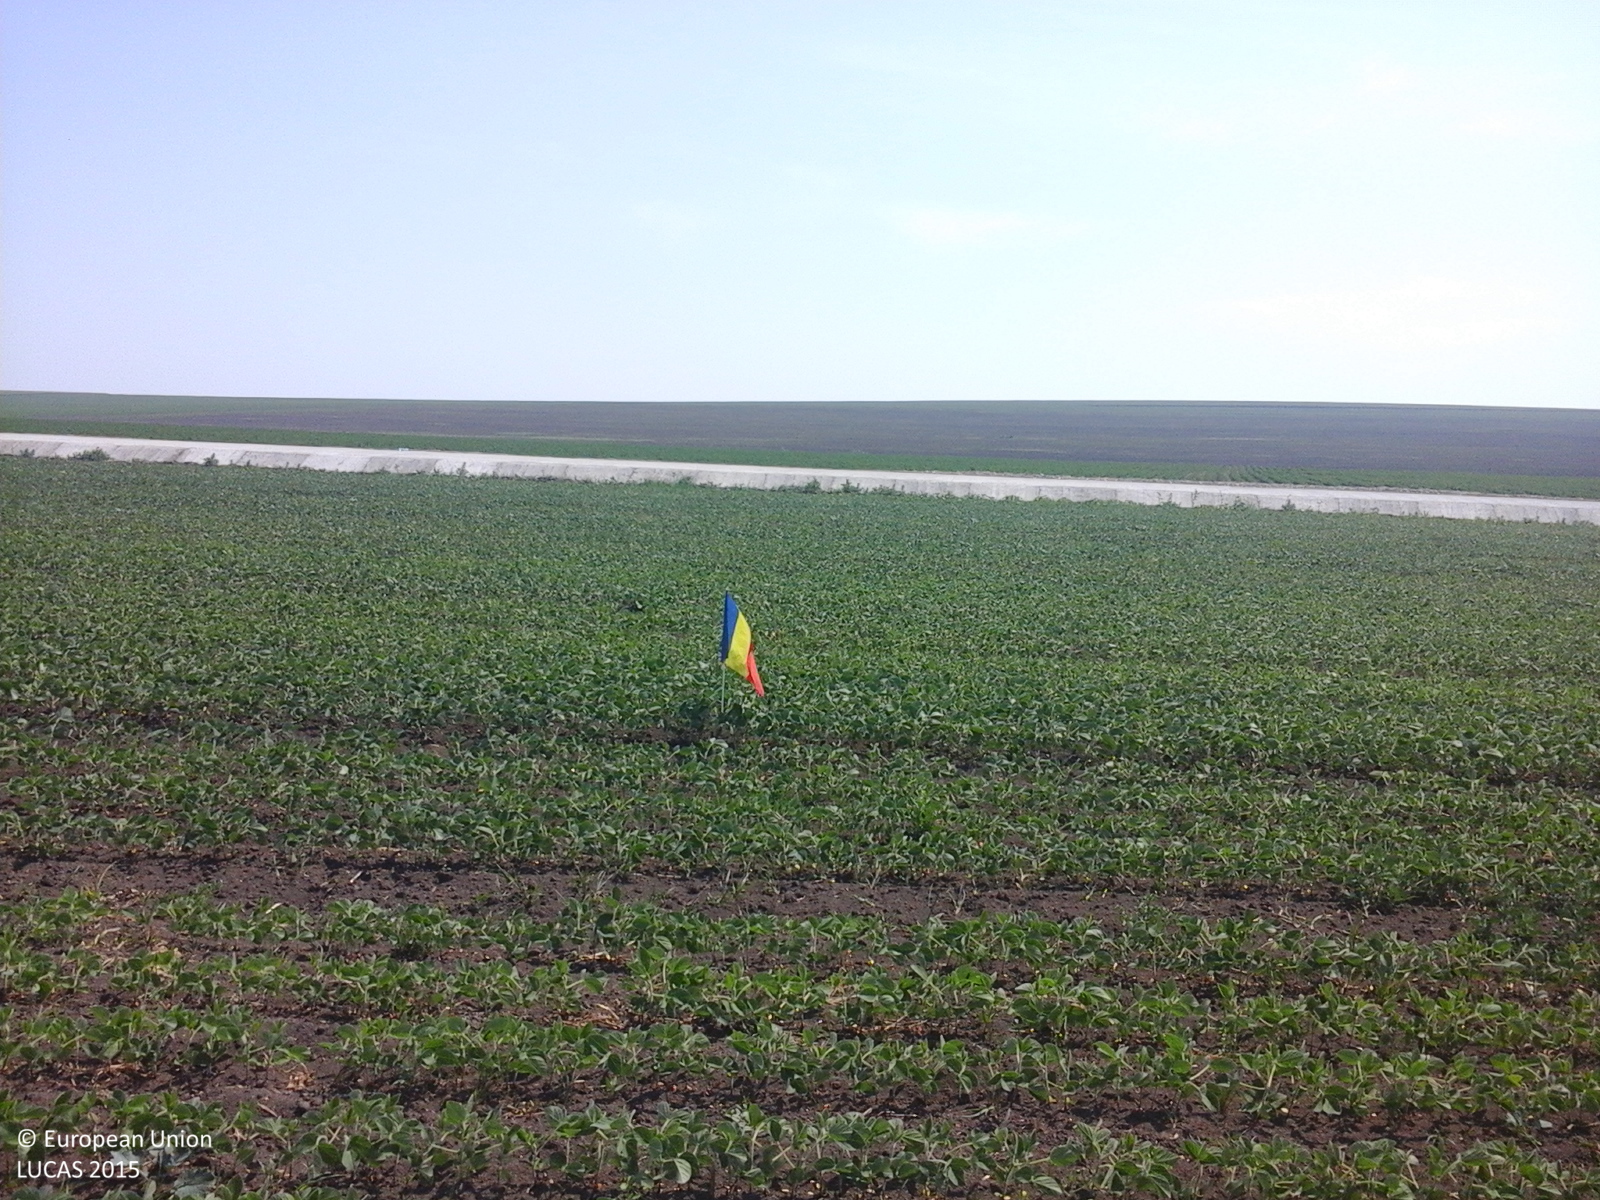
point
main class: Cropland
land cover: Soya
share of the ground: 50 - 75 %
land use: Agriculture (excluding fallow land and kitchen gardens)
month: June
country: RO
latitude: 46.8570
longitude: 26.6276
